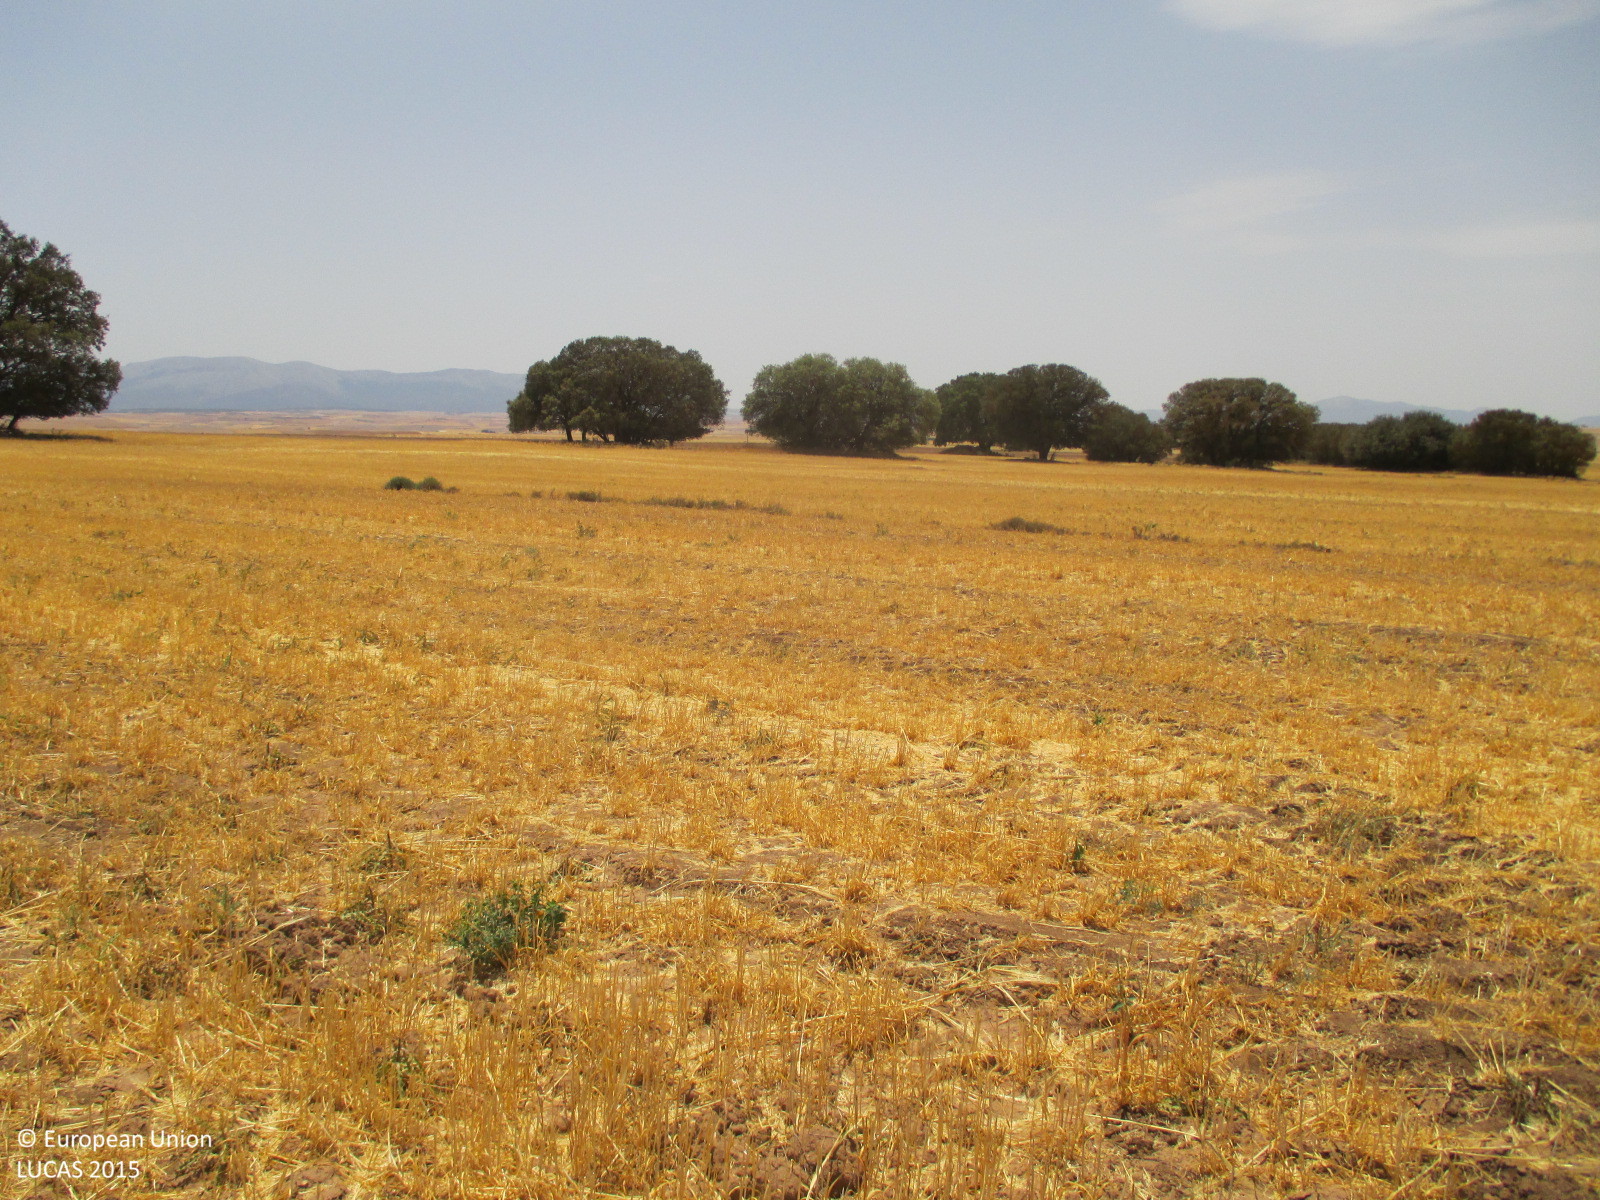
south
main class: Cropland
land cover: Barley
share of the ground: < 10 %
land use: Agriculture (excluding fallow land and kitchen gardens)
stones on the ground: < 10 %
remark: Harvested field
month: July
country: ES
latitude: 37.8469
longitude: -2.2734
